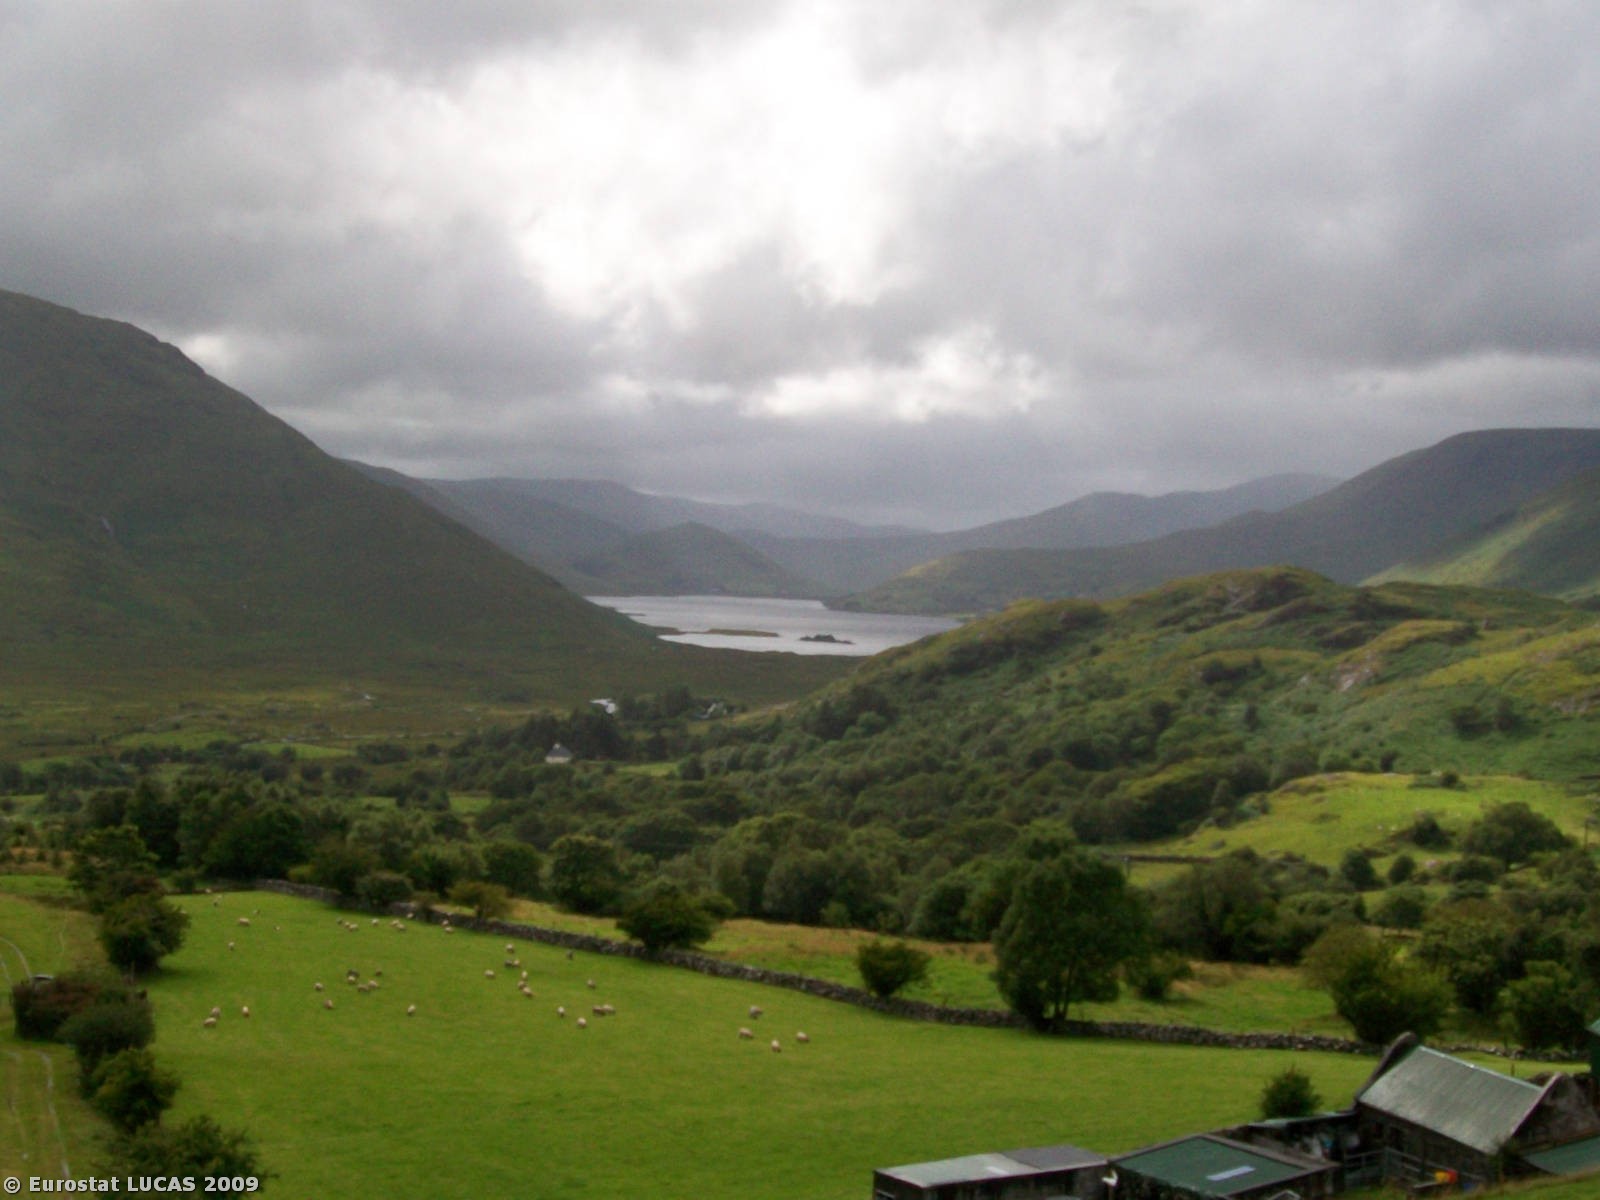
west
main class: Grassland
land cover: Grassland without tree/shrub cover
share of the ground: > 75 %
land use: Agriculture (excluding fallow land and kitchen gardens)
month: July
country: IE
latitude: 53.5749
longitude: -9.4871
